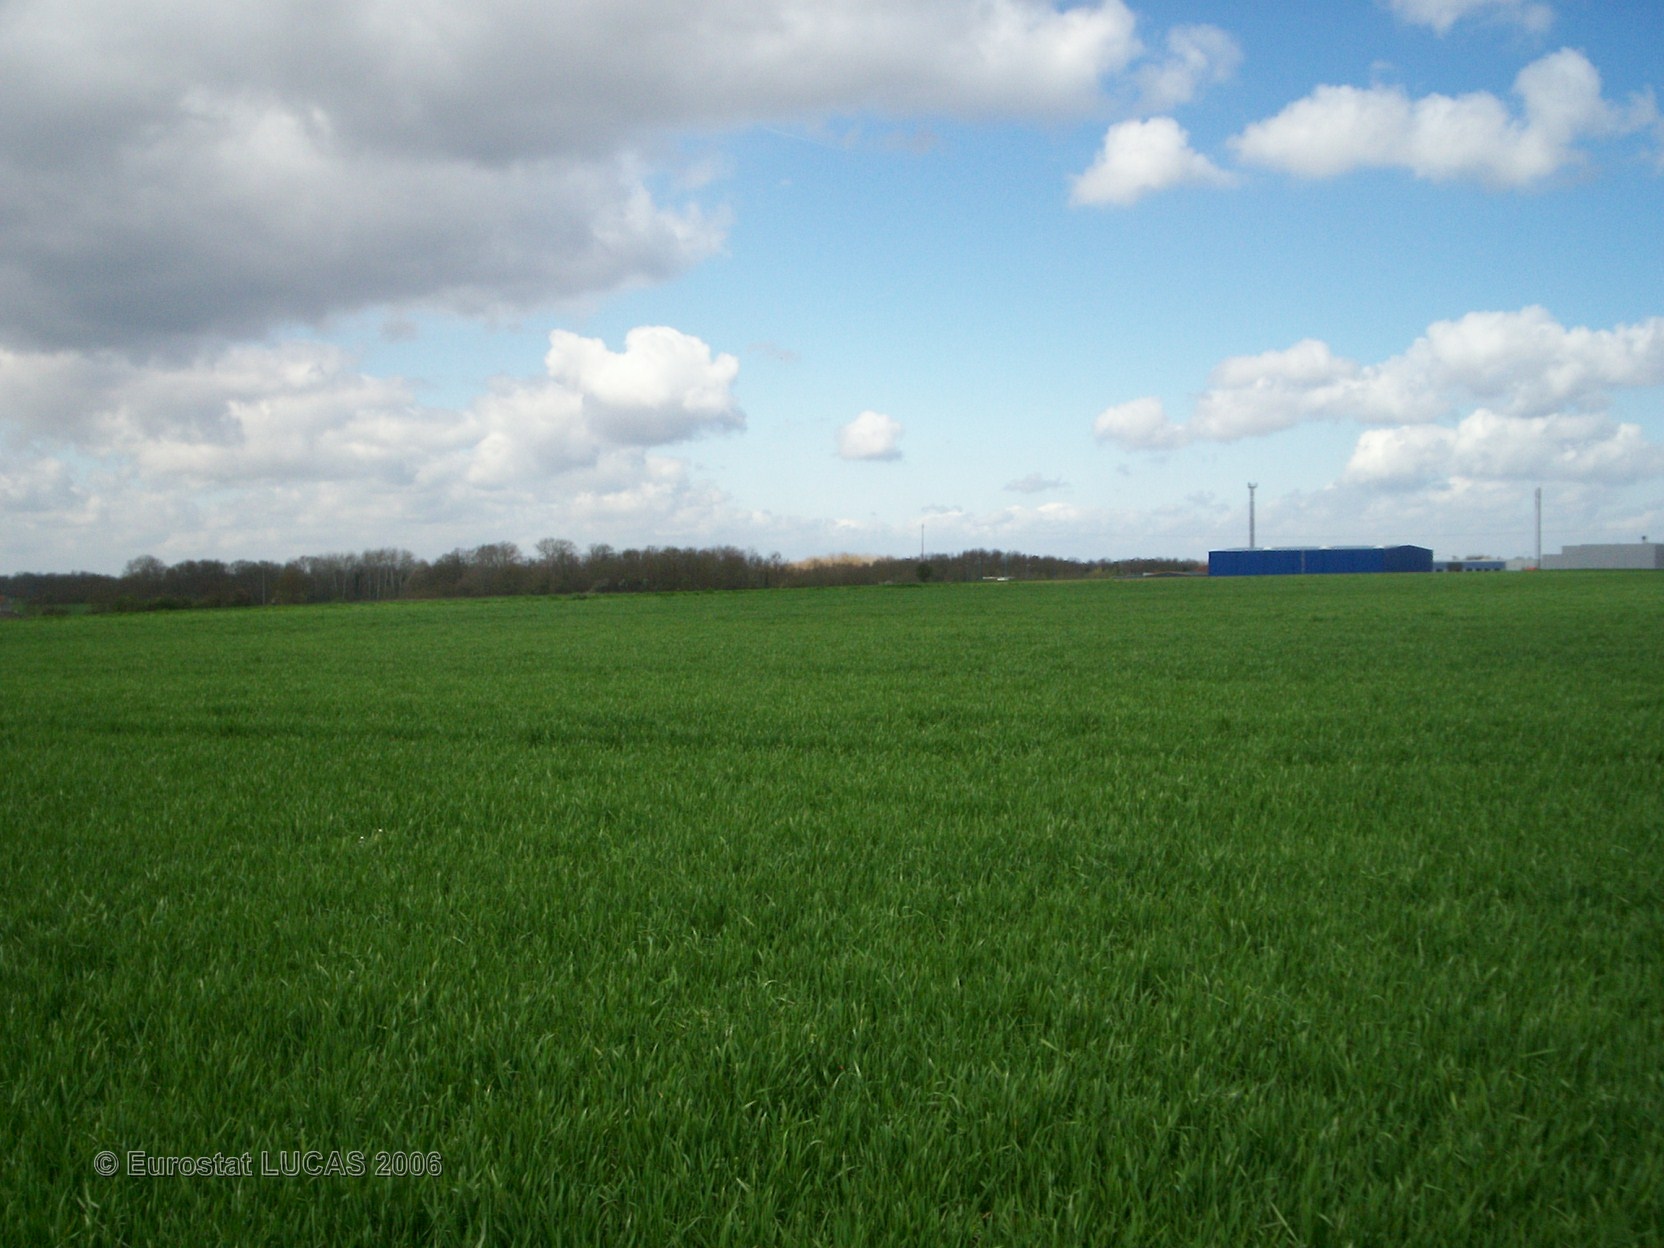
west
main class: Cropland
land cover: Common wheat
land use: Agriculture (excluding fallow land and kitchen gardens)
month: April
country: FR
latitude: 48.4941
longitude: 2.8054
